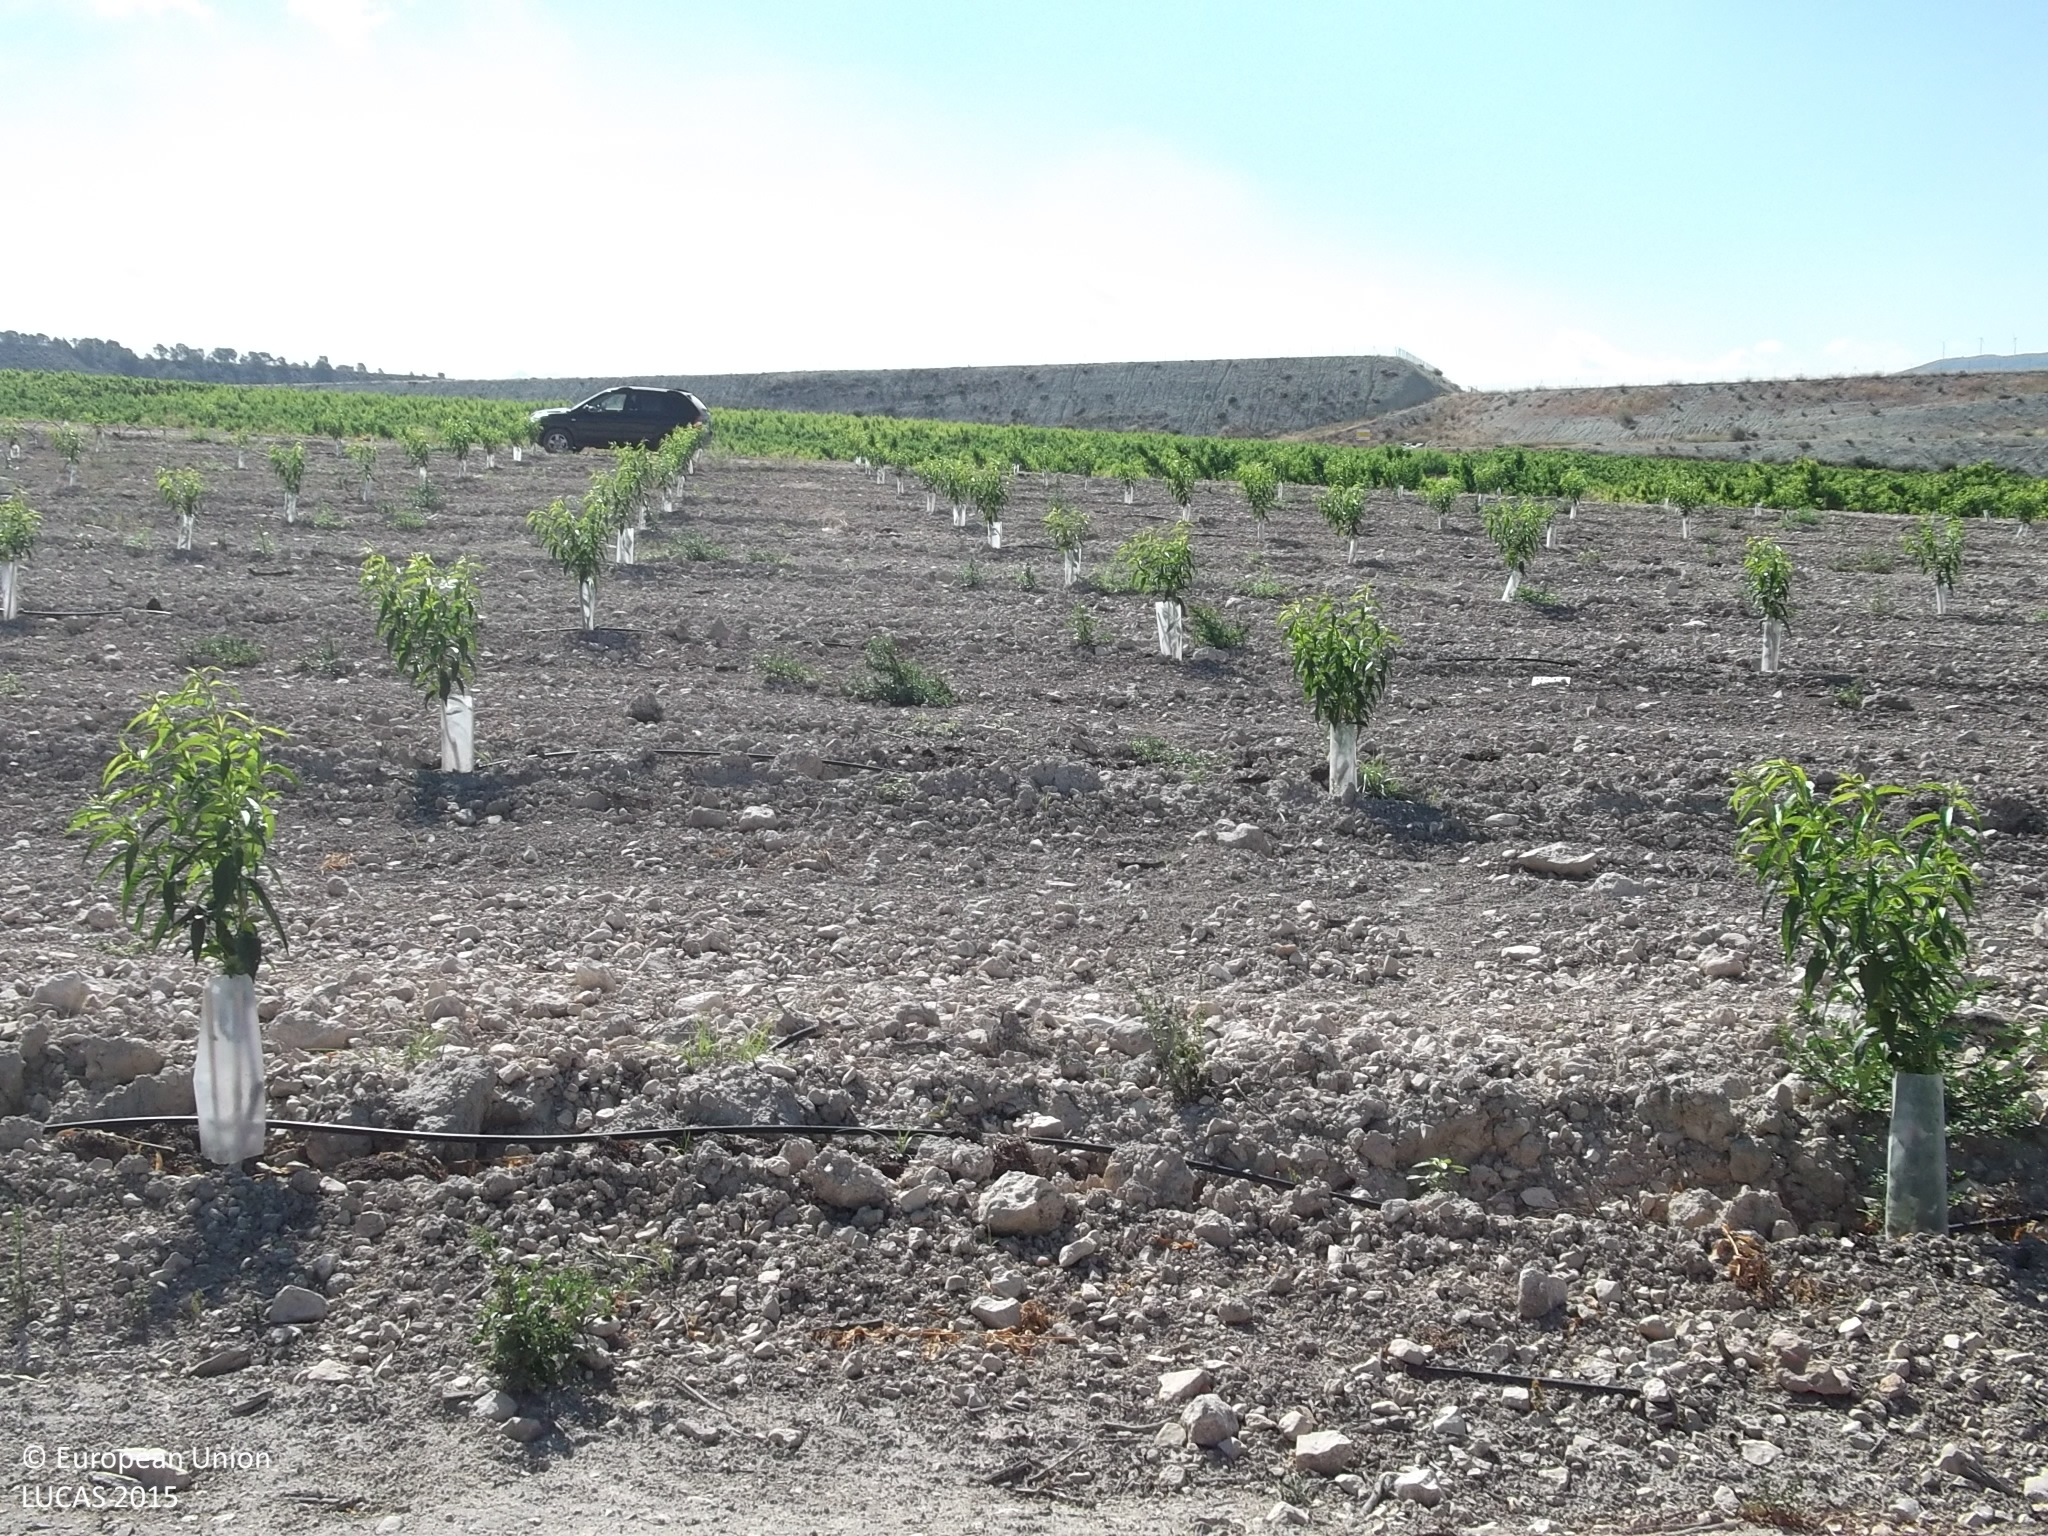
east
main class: Cropland
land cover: Other fruit trees and berries
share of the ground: 10 - 25 %
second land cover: Other bare soil
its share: > 75 %
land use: Agriculture (excluding fallow land and kitchen gardens)
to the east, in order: Other fruit trees and berries; Other bare soil; Tracks; Other fruit trees and berries; Tracks; Grass margins; Tracks; Other fruit trees and berries; Tracks; Other fruit trees and berries
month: May
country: ES
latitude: 38.3198
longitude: -1.4158
